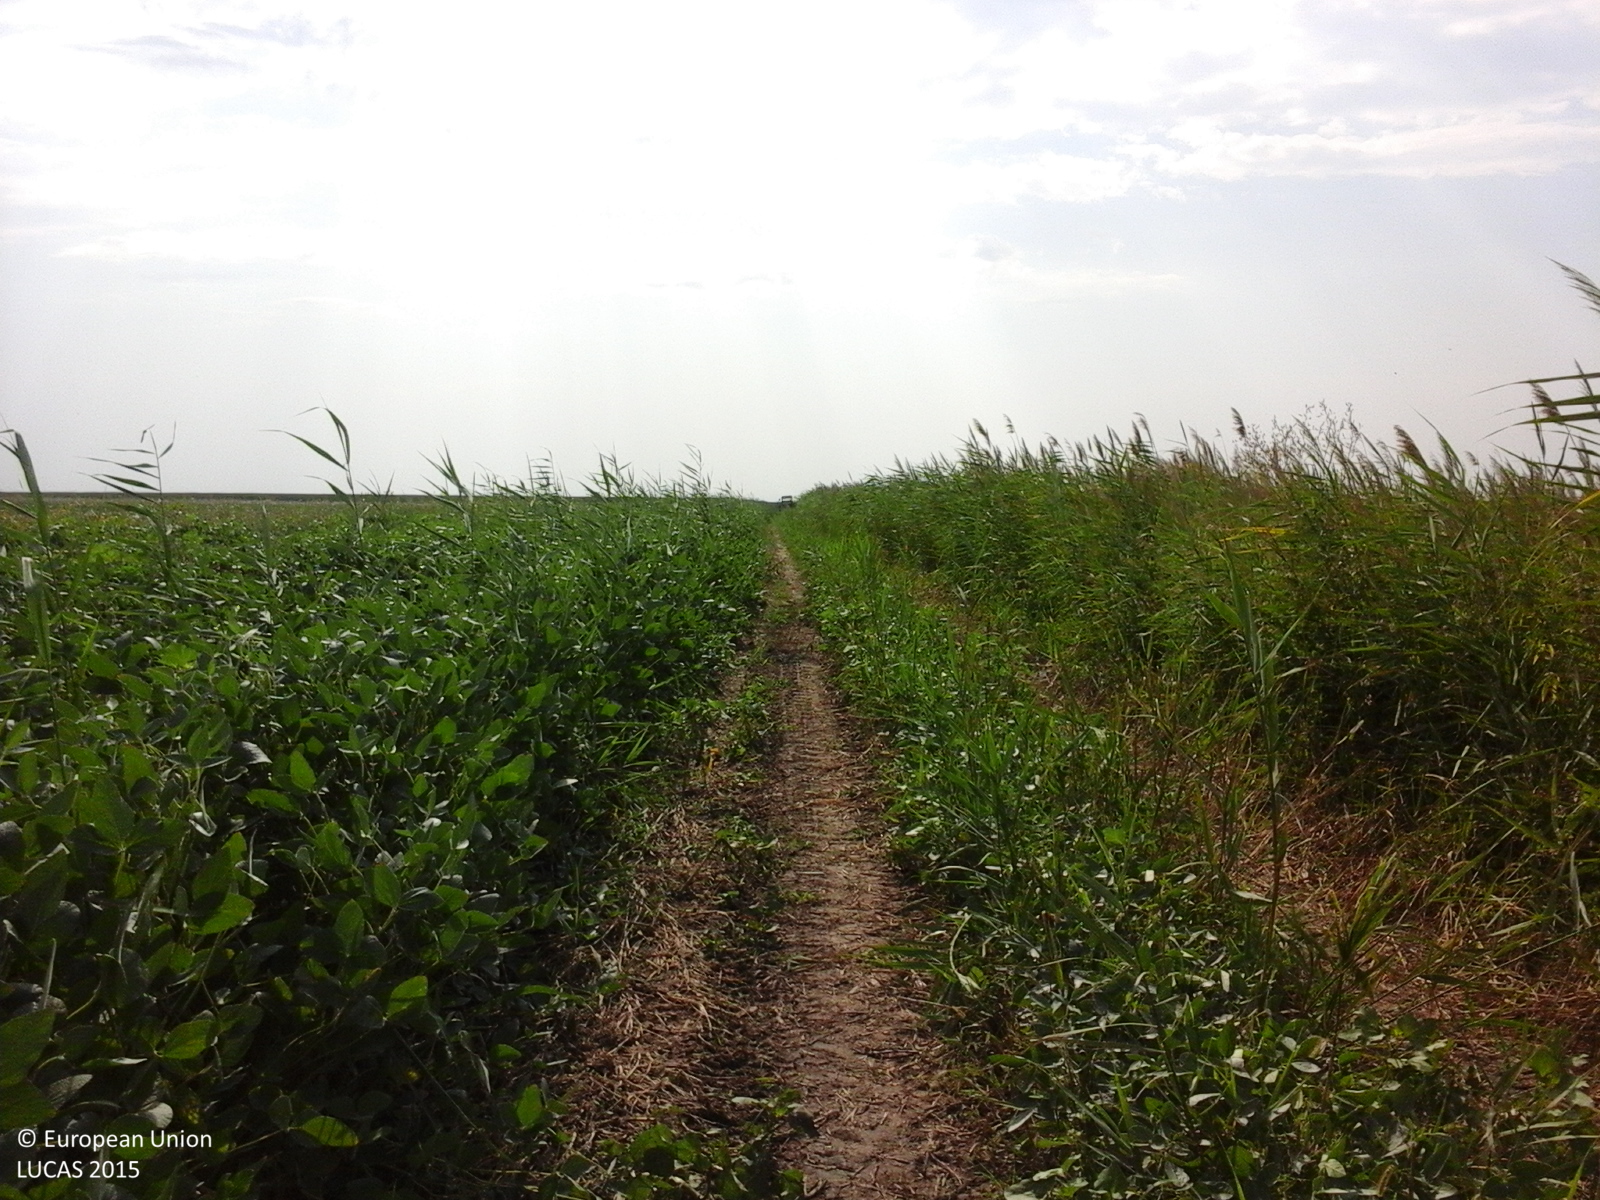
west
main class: Cropland
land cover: Soya
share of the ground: > 75 %
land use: Agriculture (excluding fallow land and kitchen gardens)
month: August
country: RO
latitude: 45.1202
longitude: 27.6857
